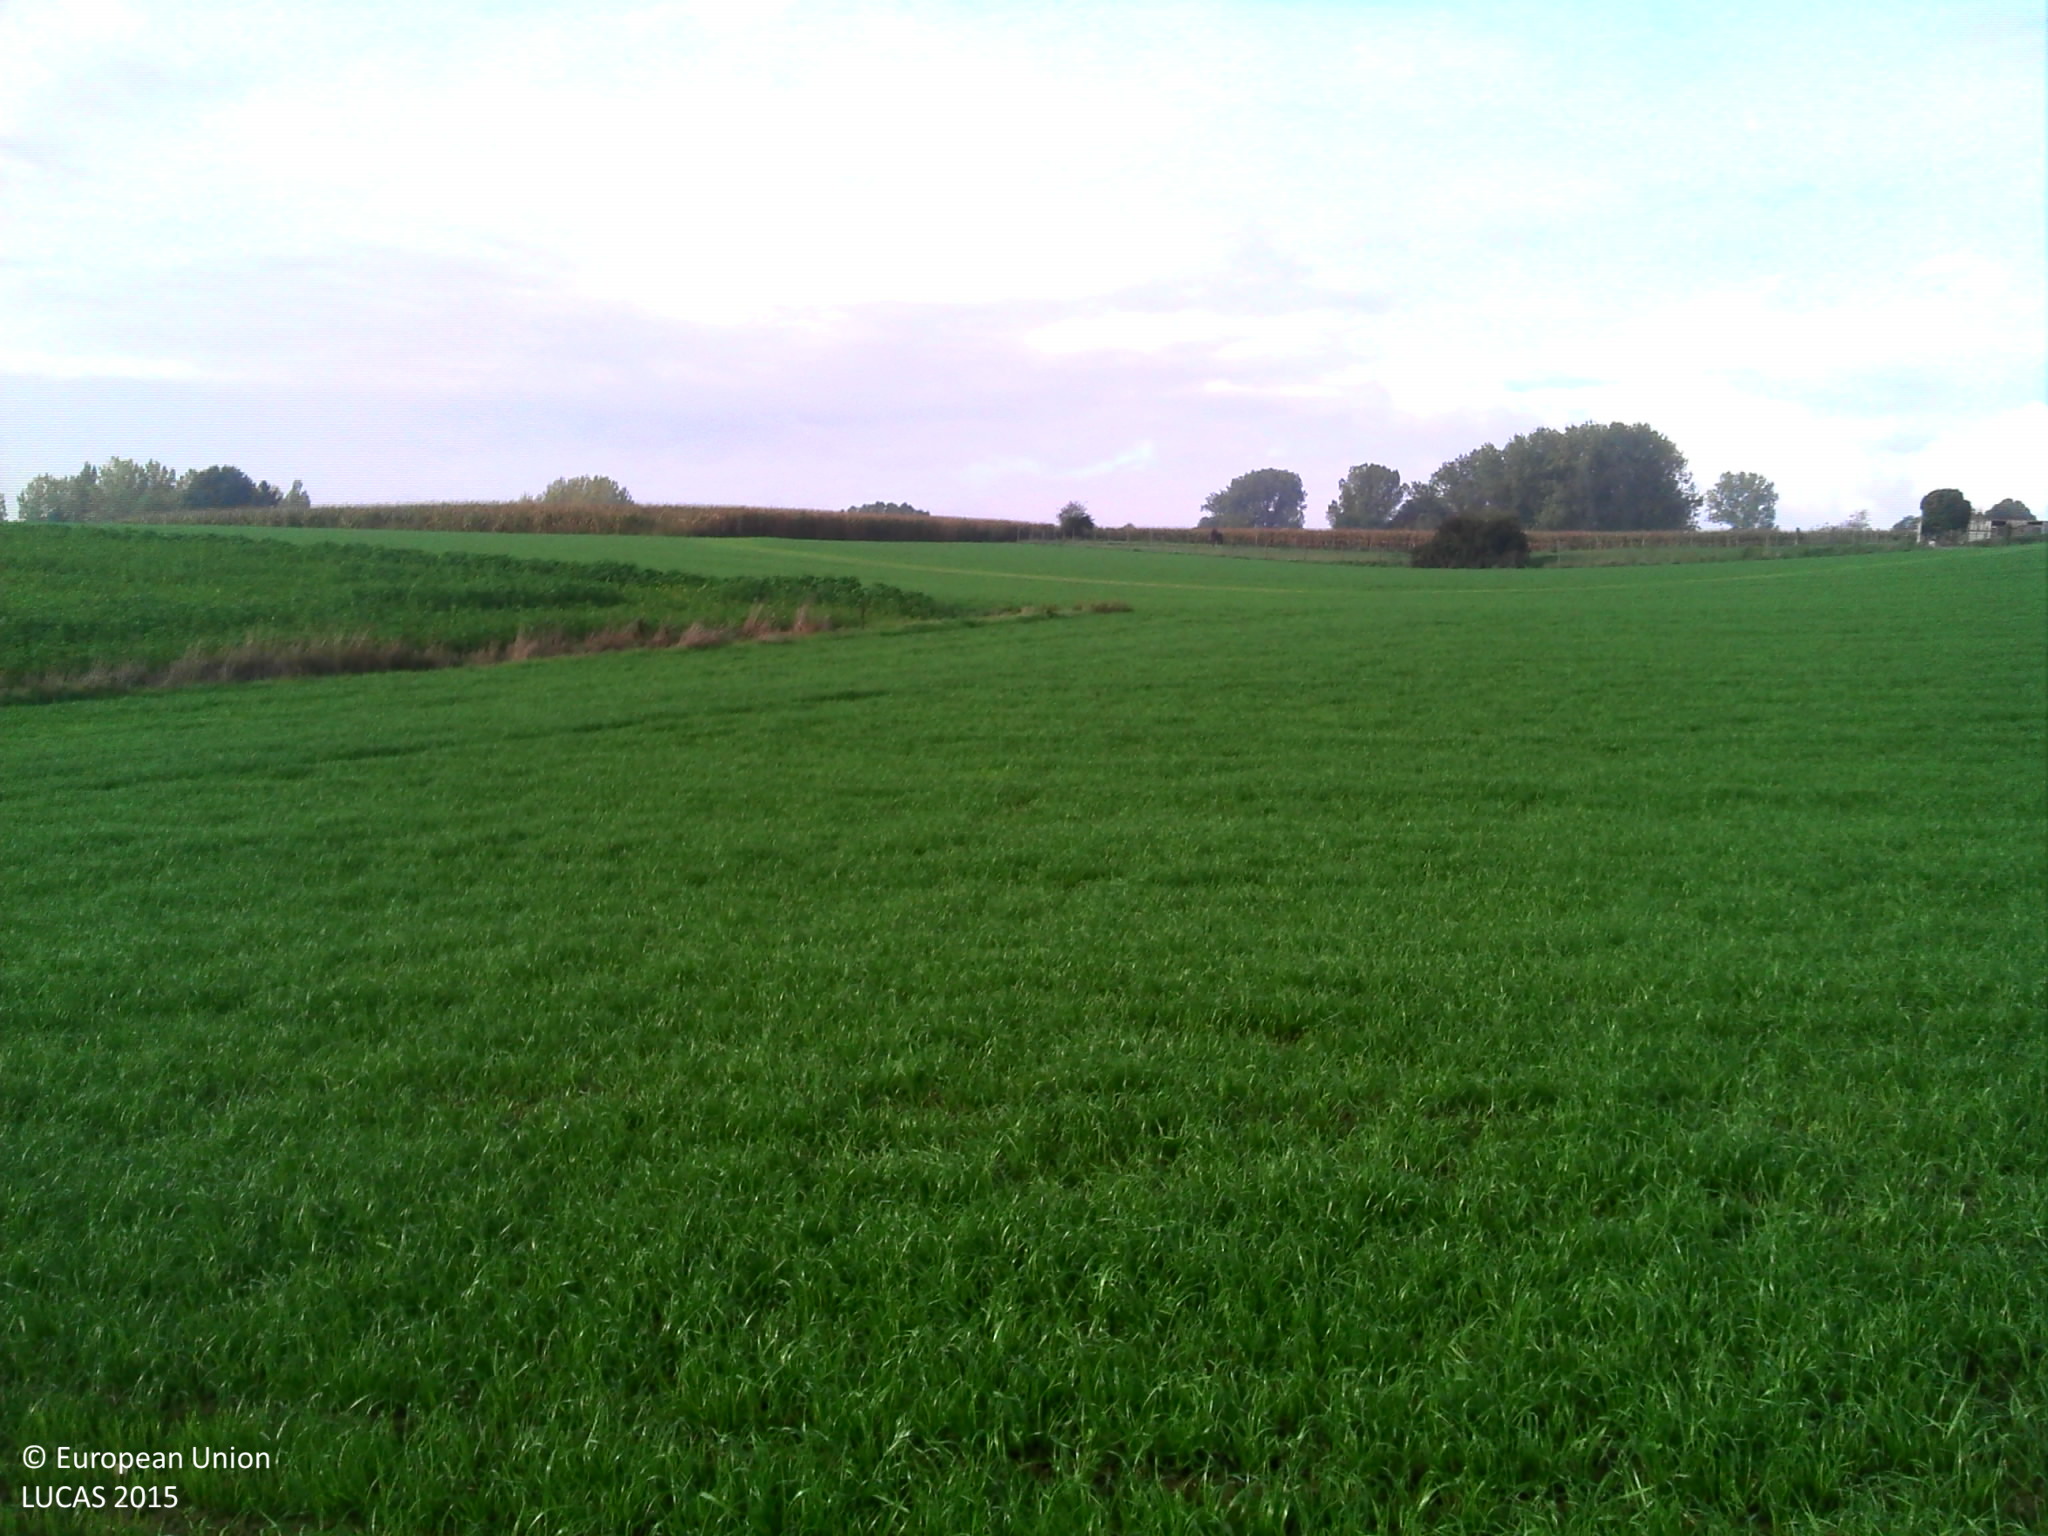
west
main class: Cropland
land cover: Temporary grasslands
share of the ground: > 75 %
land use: Agriculture (excluding fallow land and kitchen gardens)
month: October
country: BE
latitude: 50.6922
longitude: 3.9778
